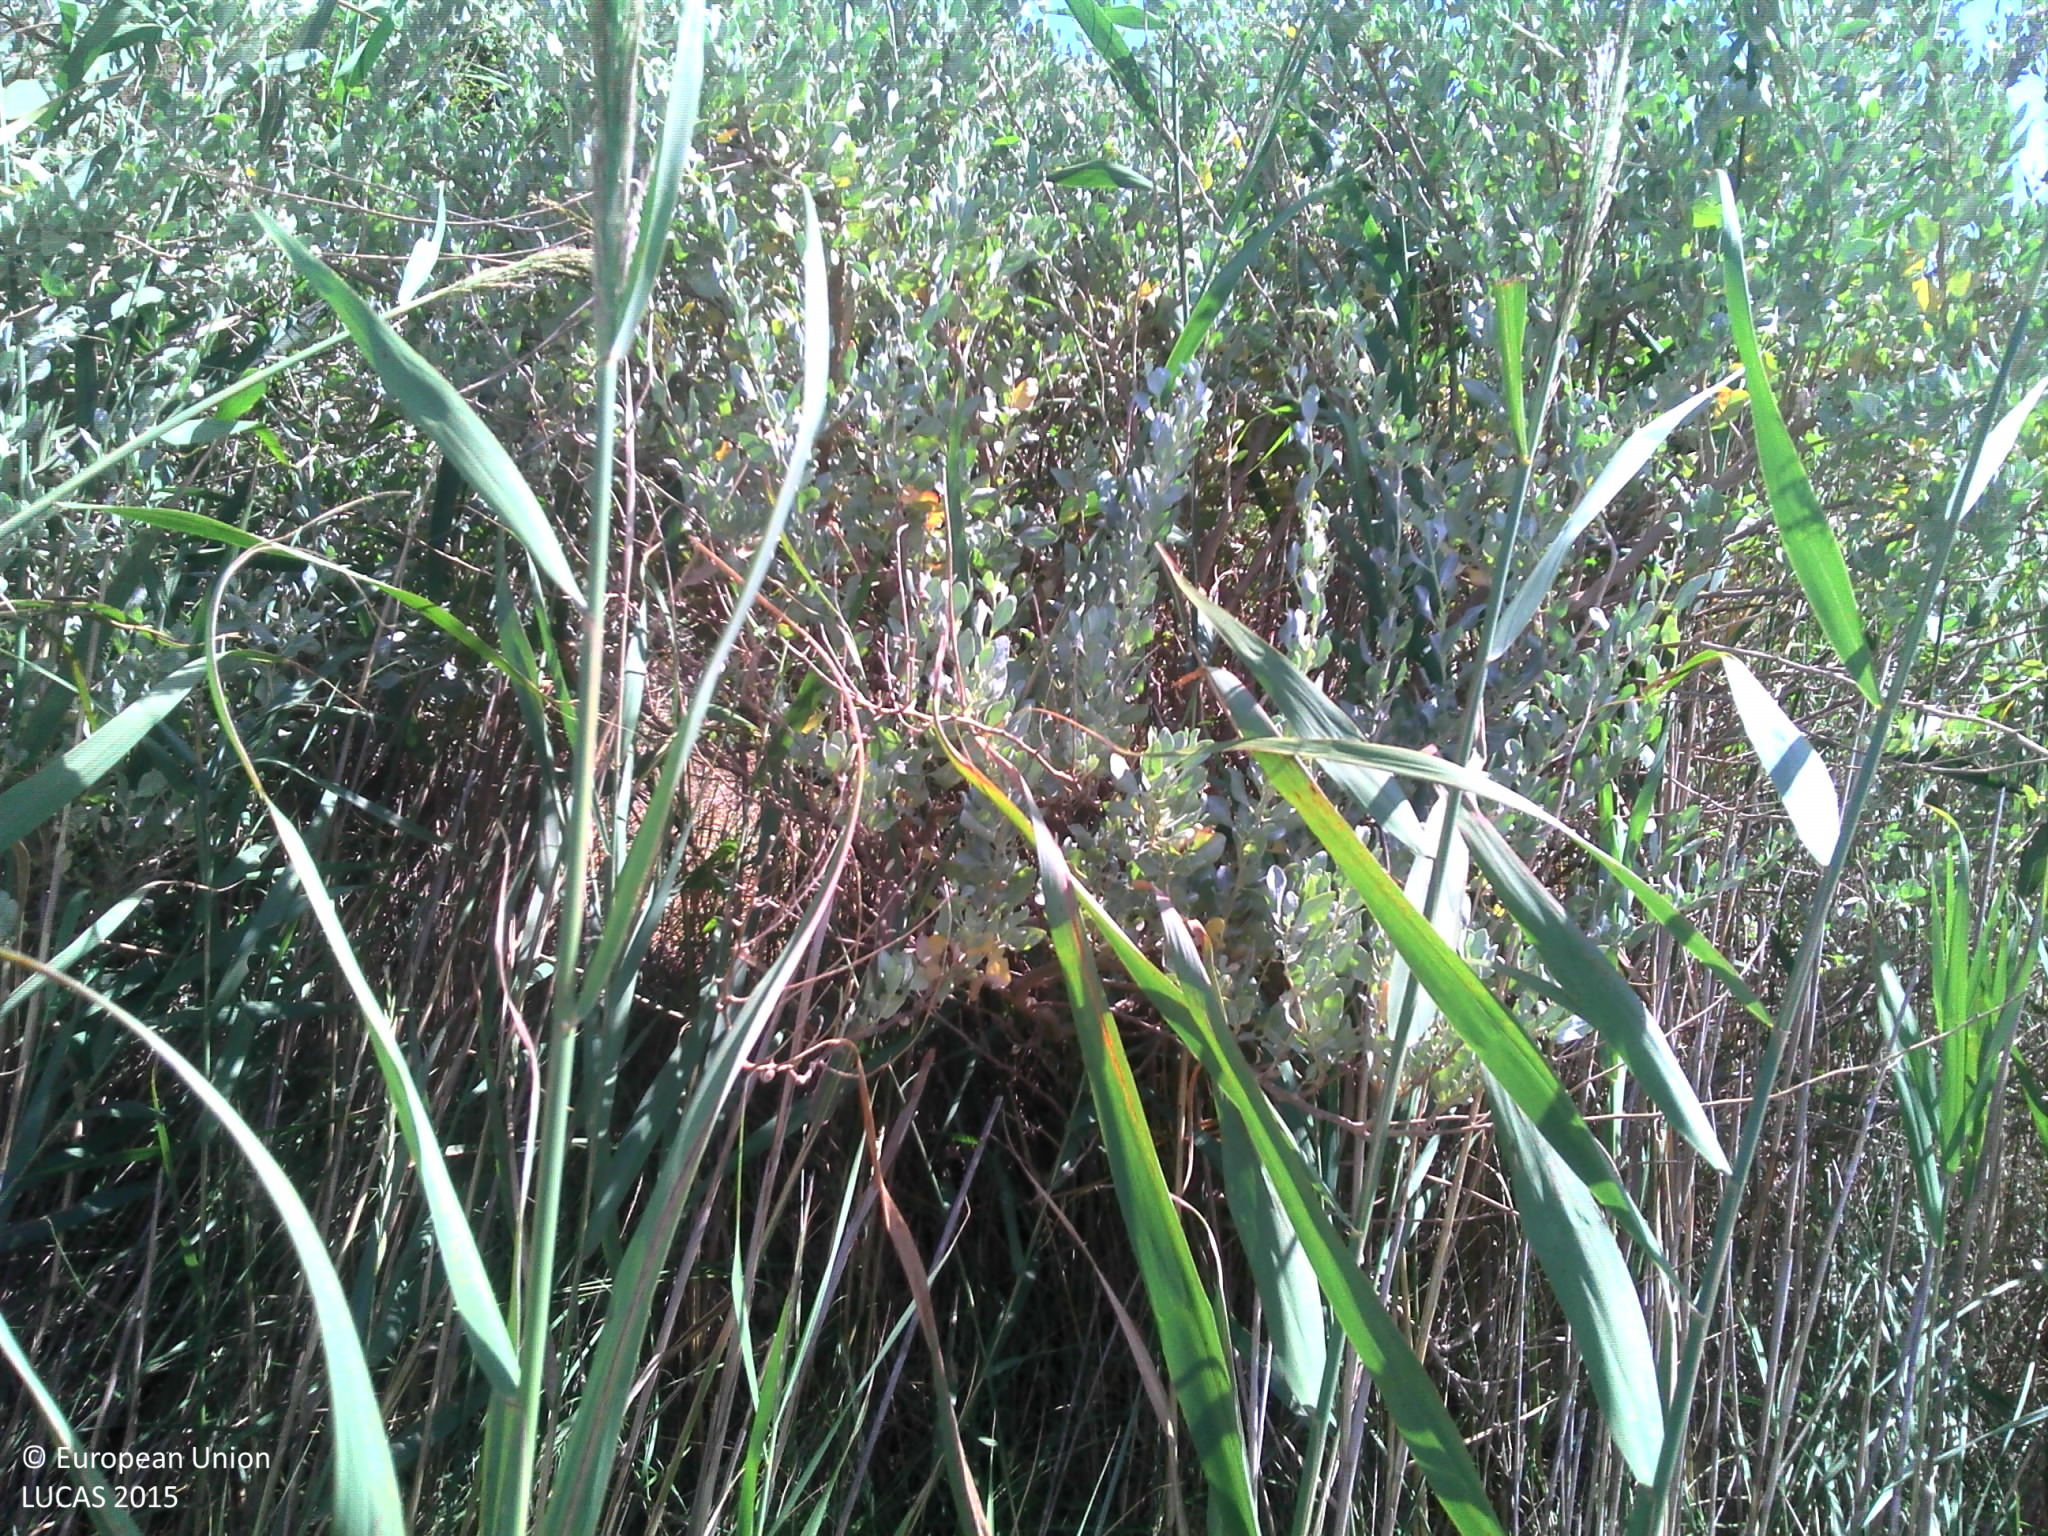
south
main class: Grassland
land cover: Spontaneously vegetated surfaces
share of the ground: > 75 %
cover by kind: herbaceous plants 55 %, consolidated bare surface 20 %, unconsolidated bare surface 20 %, shrubs 5 %
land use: Energy production
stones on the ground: 10 - 25 %
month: July
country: FR
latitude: 43.4421
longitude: 4.7838
